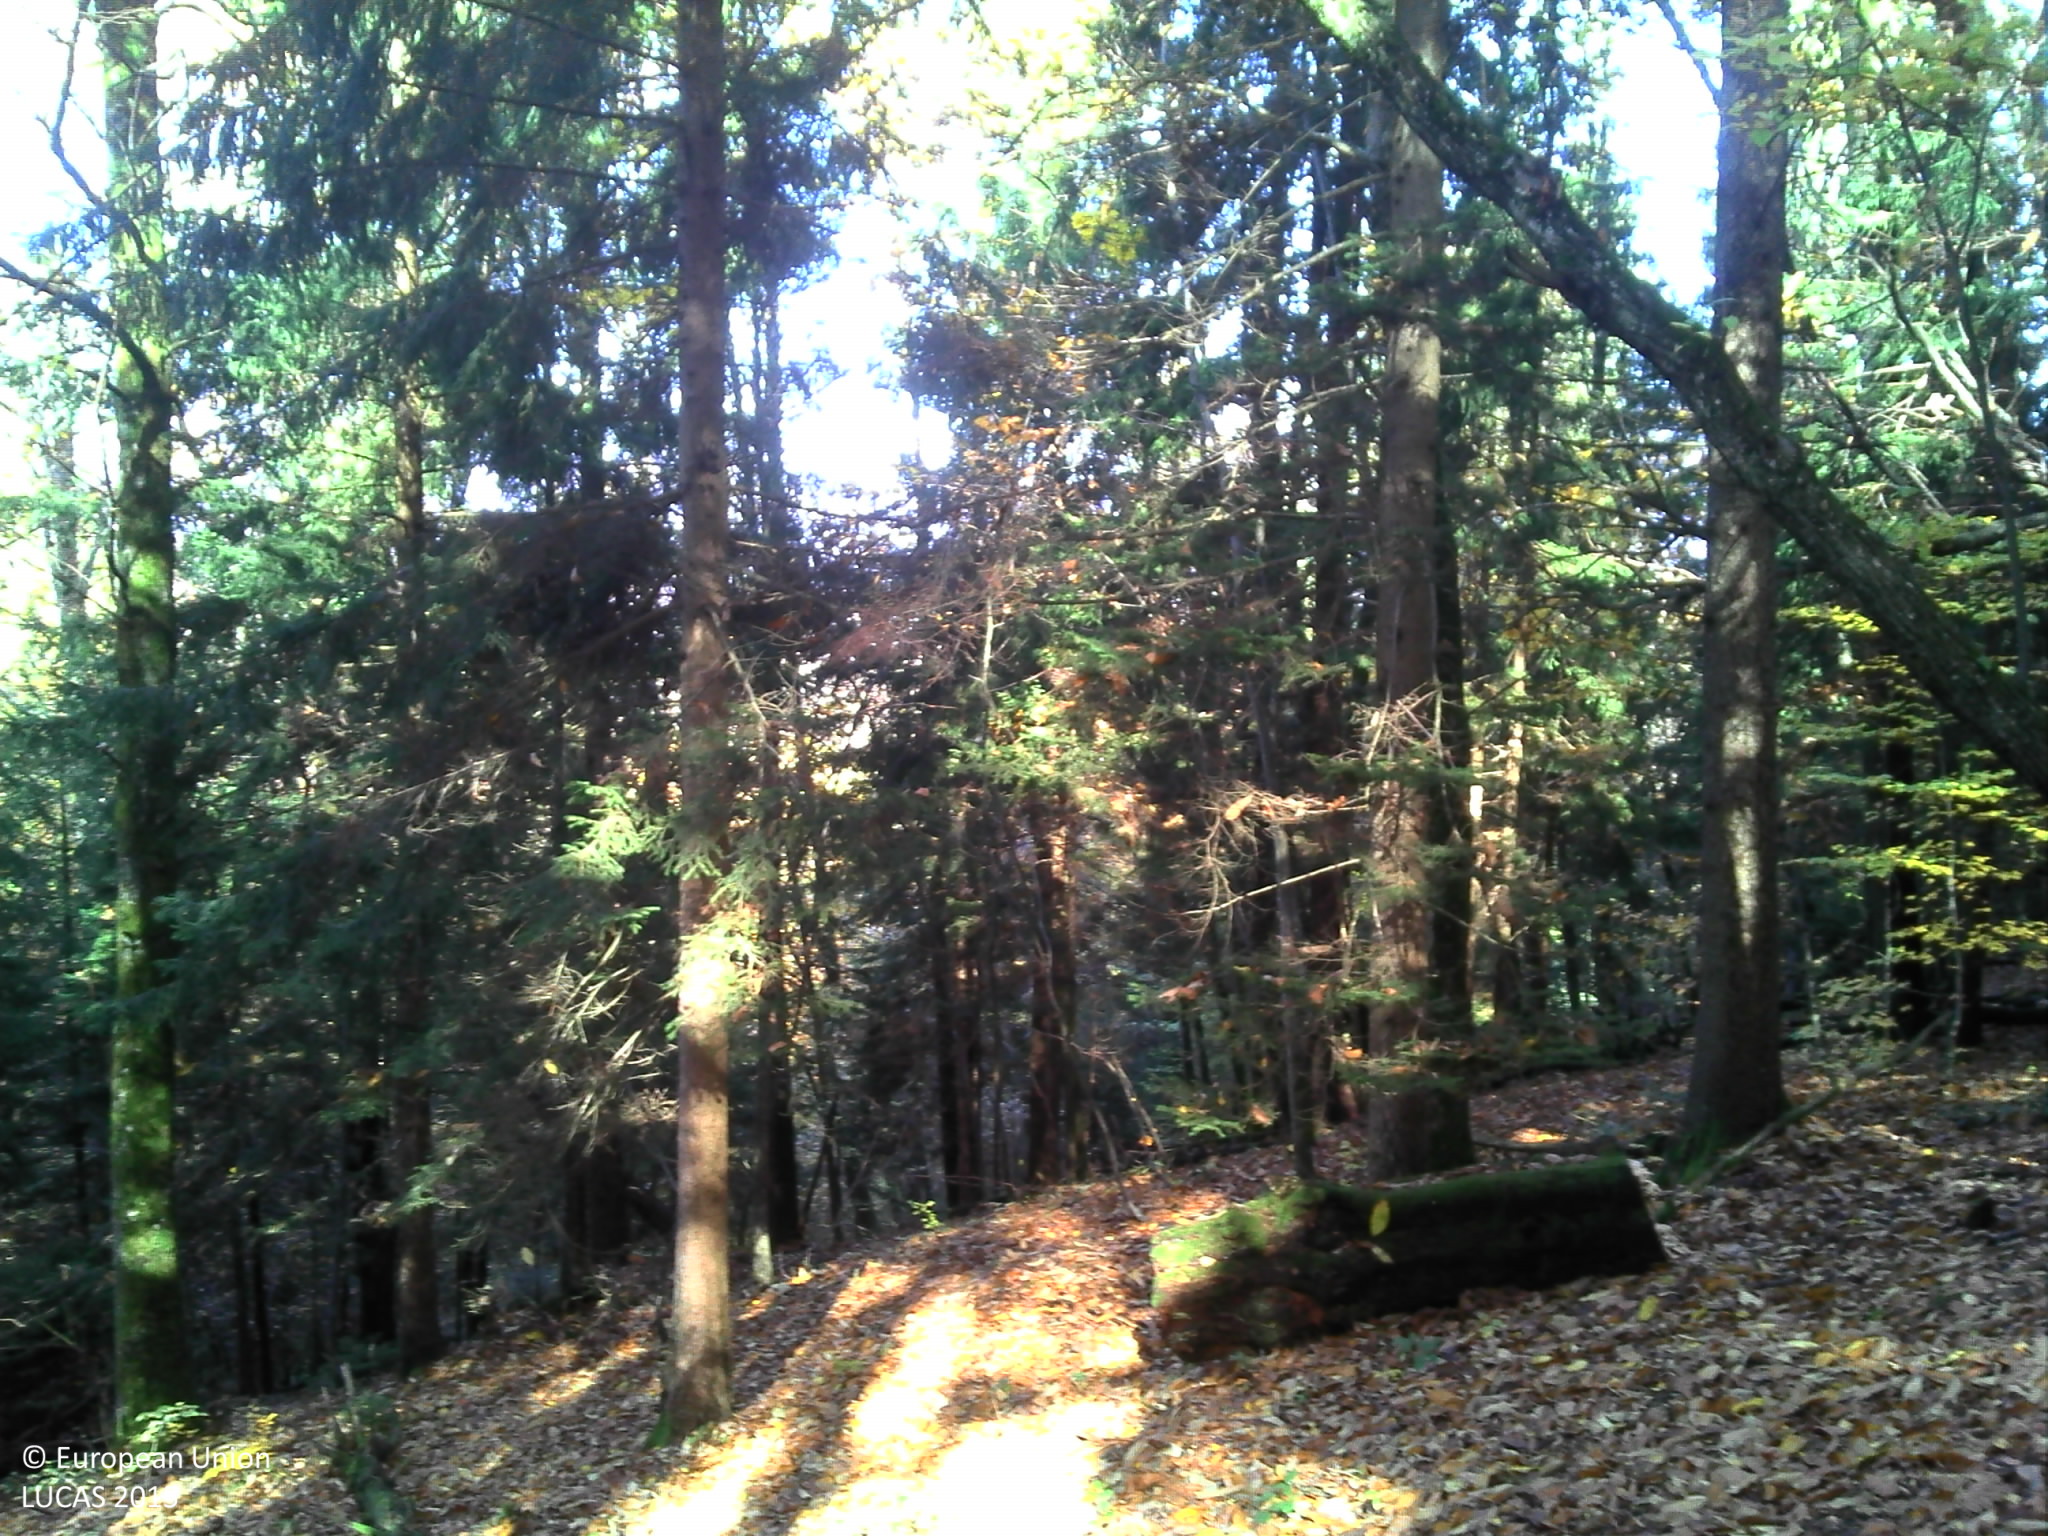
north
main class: Woodland
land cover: Spruce dominated mixed woodland
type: hemiboreal forest and nemoral coniferous forest and mixed broadleaved-coniferous forest
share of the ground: > 75 %
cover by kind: coniferous forest trees 45 %, broadleaved forest trees 45 %, unconsolidated bare surface 10 %
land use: Forestry
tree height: > 5 m
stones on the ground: < 10 %
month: October
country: FR
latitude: 45.4705
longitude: 6.1547
